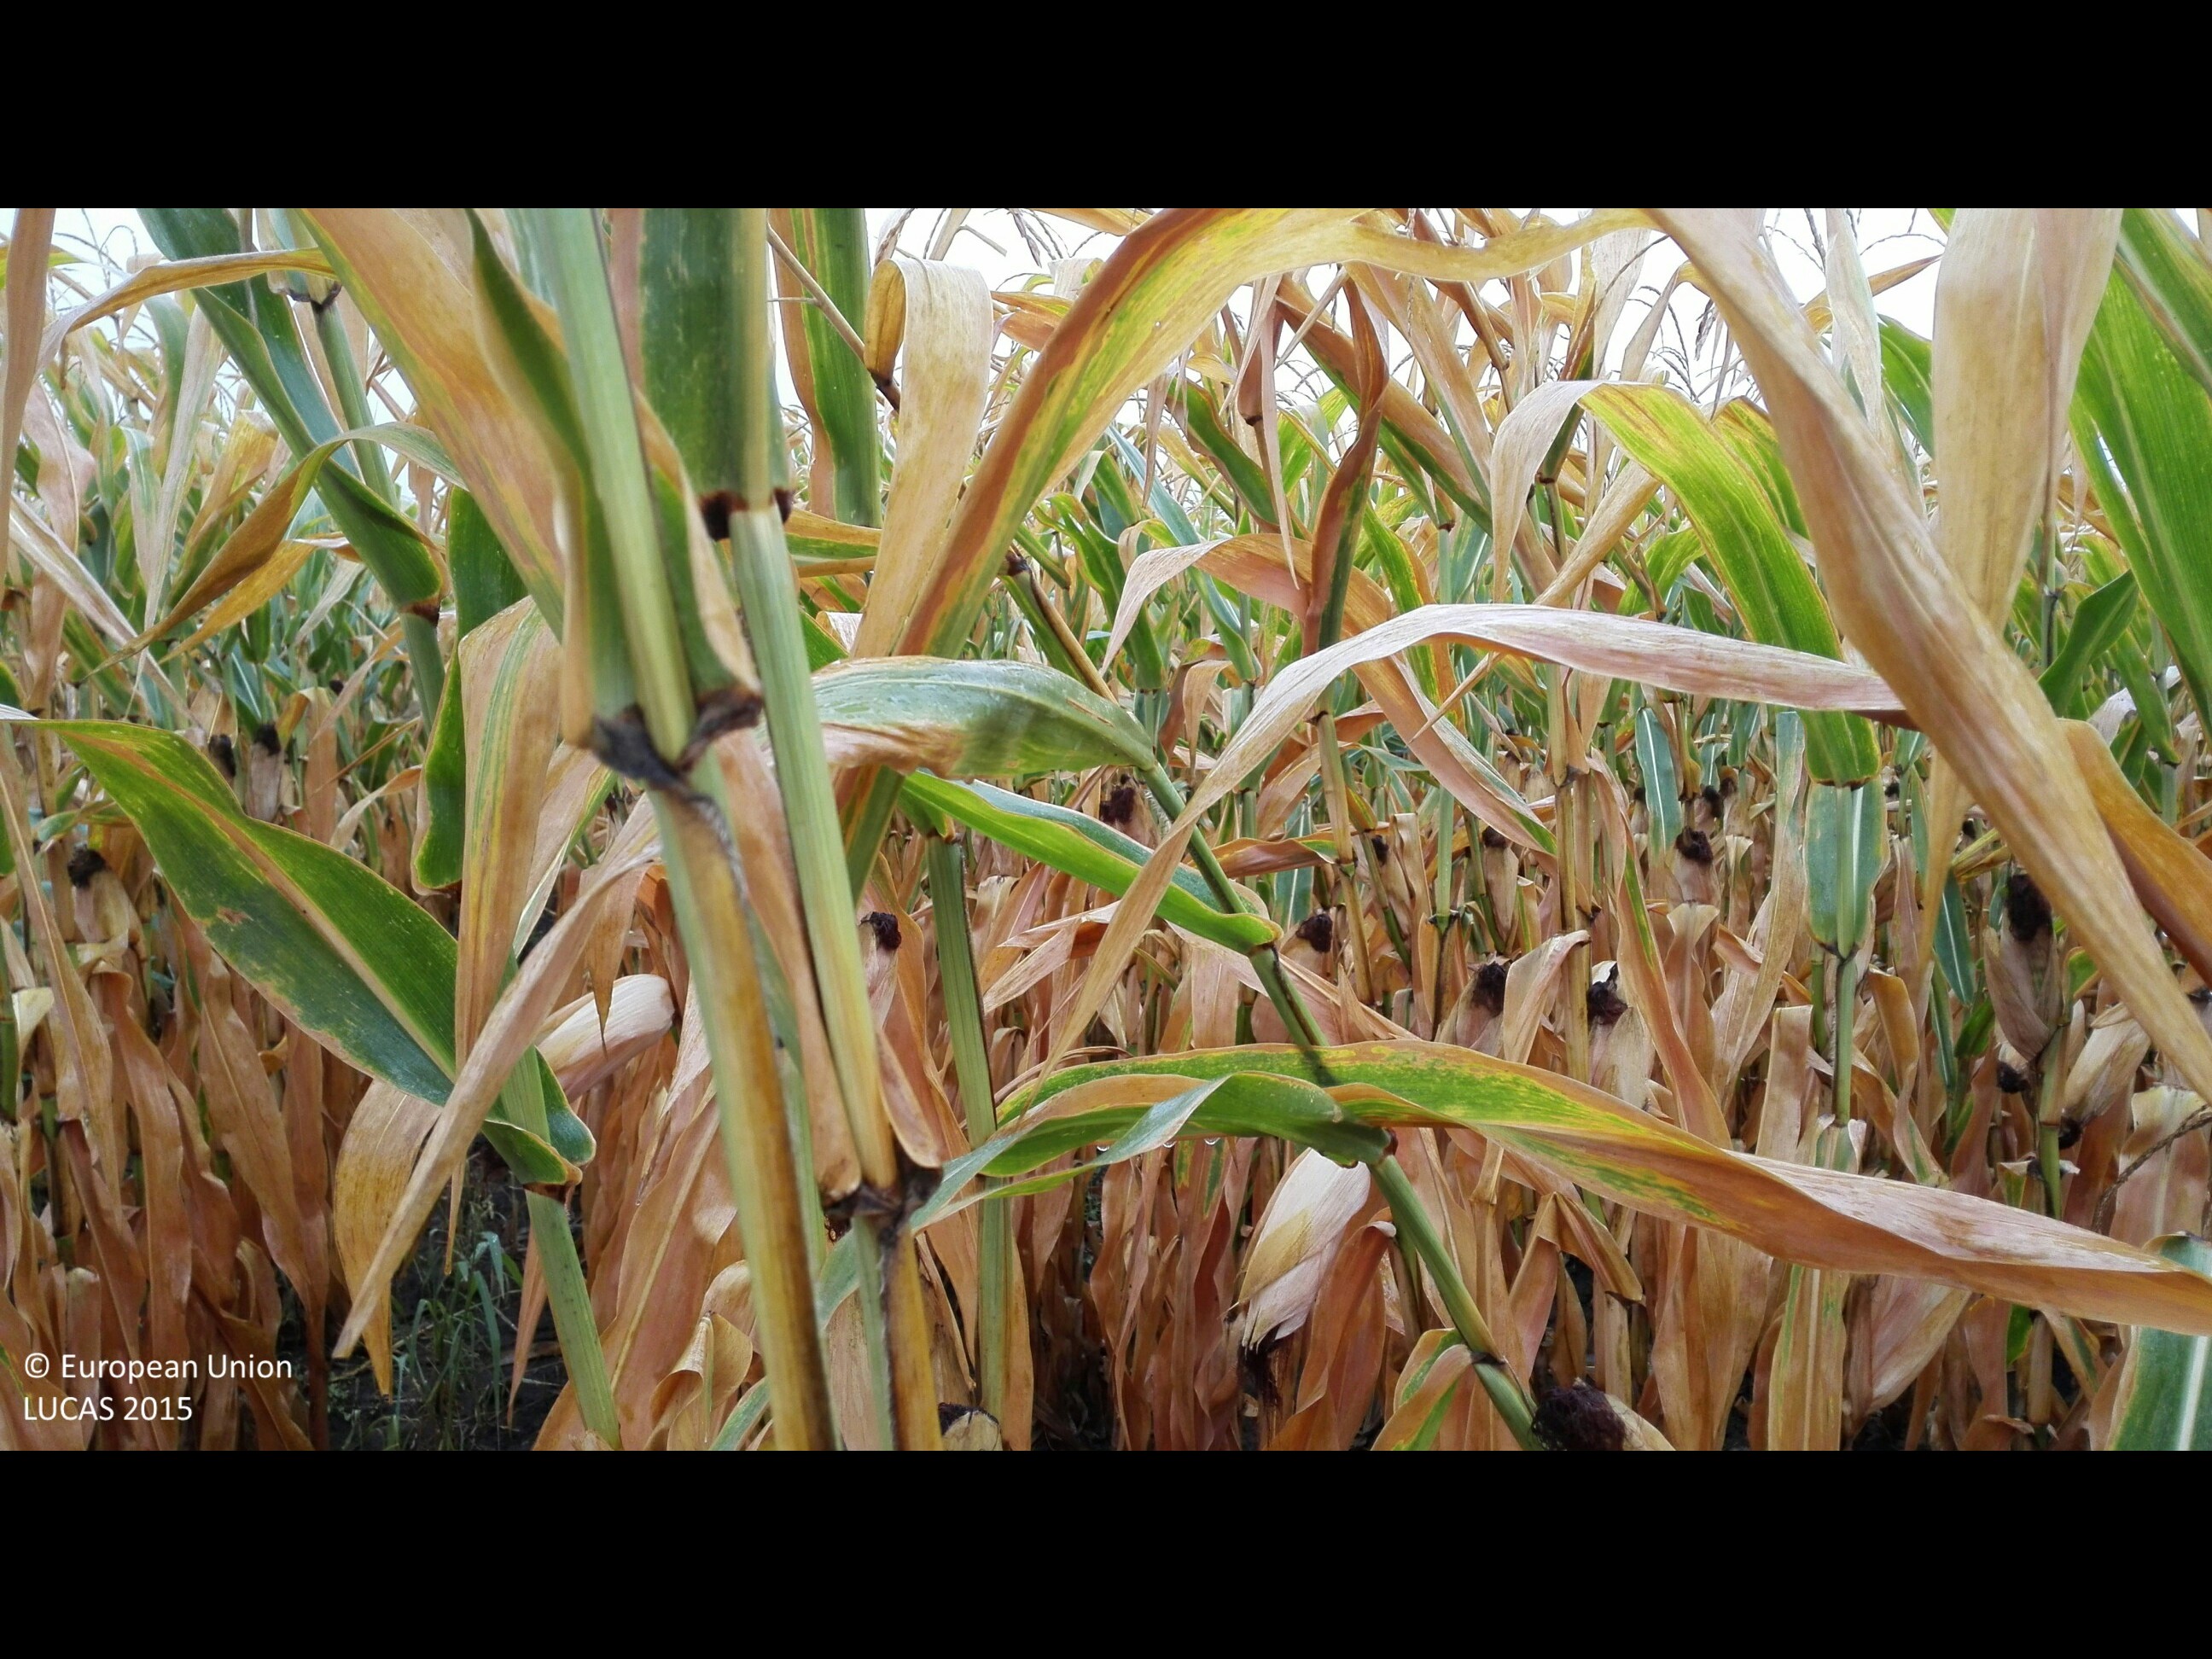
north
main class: Cropland
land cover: Maize
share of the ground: > 75 %
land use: Agriculture (excluding fallow land and kitchen gardens)
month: August
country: HU
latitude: 47.2478
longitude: 21.5769
